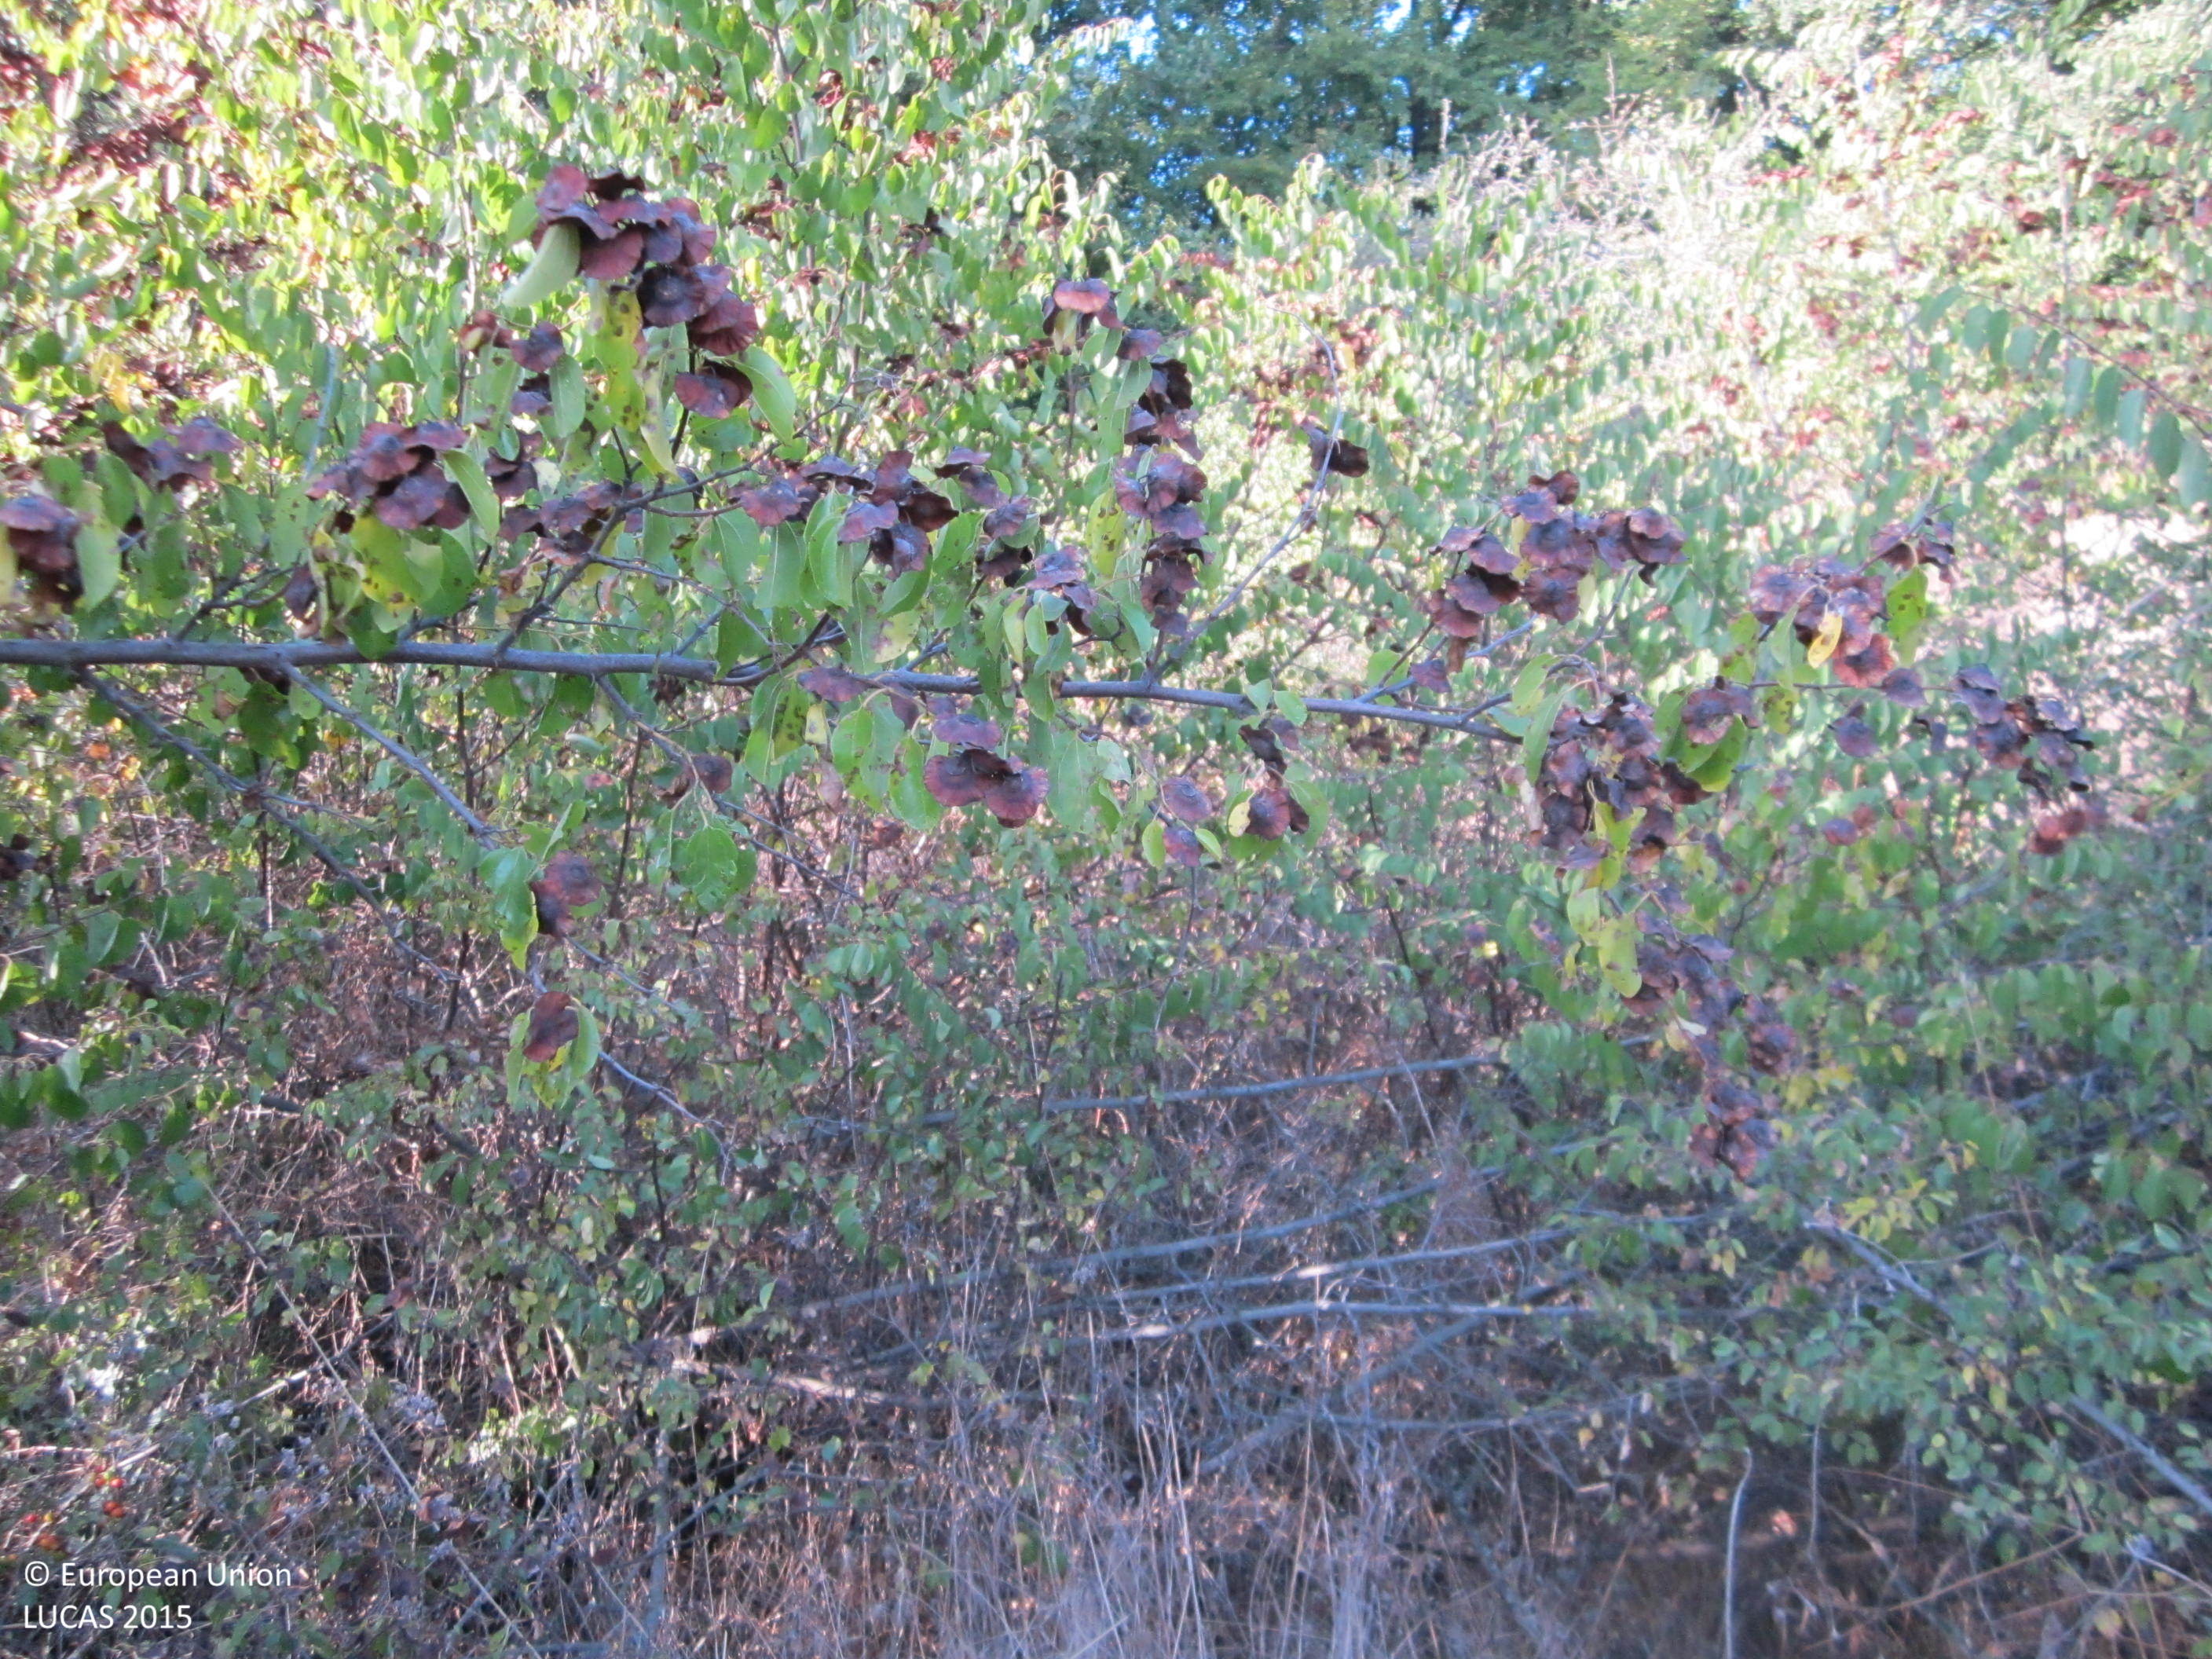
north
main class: Shrubland
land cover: Shrubland with sparse tree cover
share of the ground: > 75 %
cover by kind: shrubs 80 %, herbaceous plants 15 %, broadleaved forest trees 5 %
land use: Semi-natural and natural areas not in use
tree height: < 5 m
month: September
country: BG
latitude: 42.6630
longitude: 27.4053
